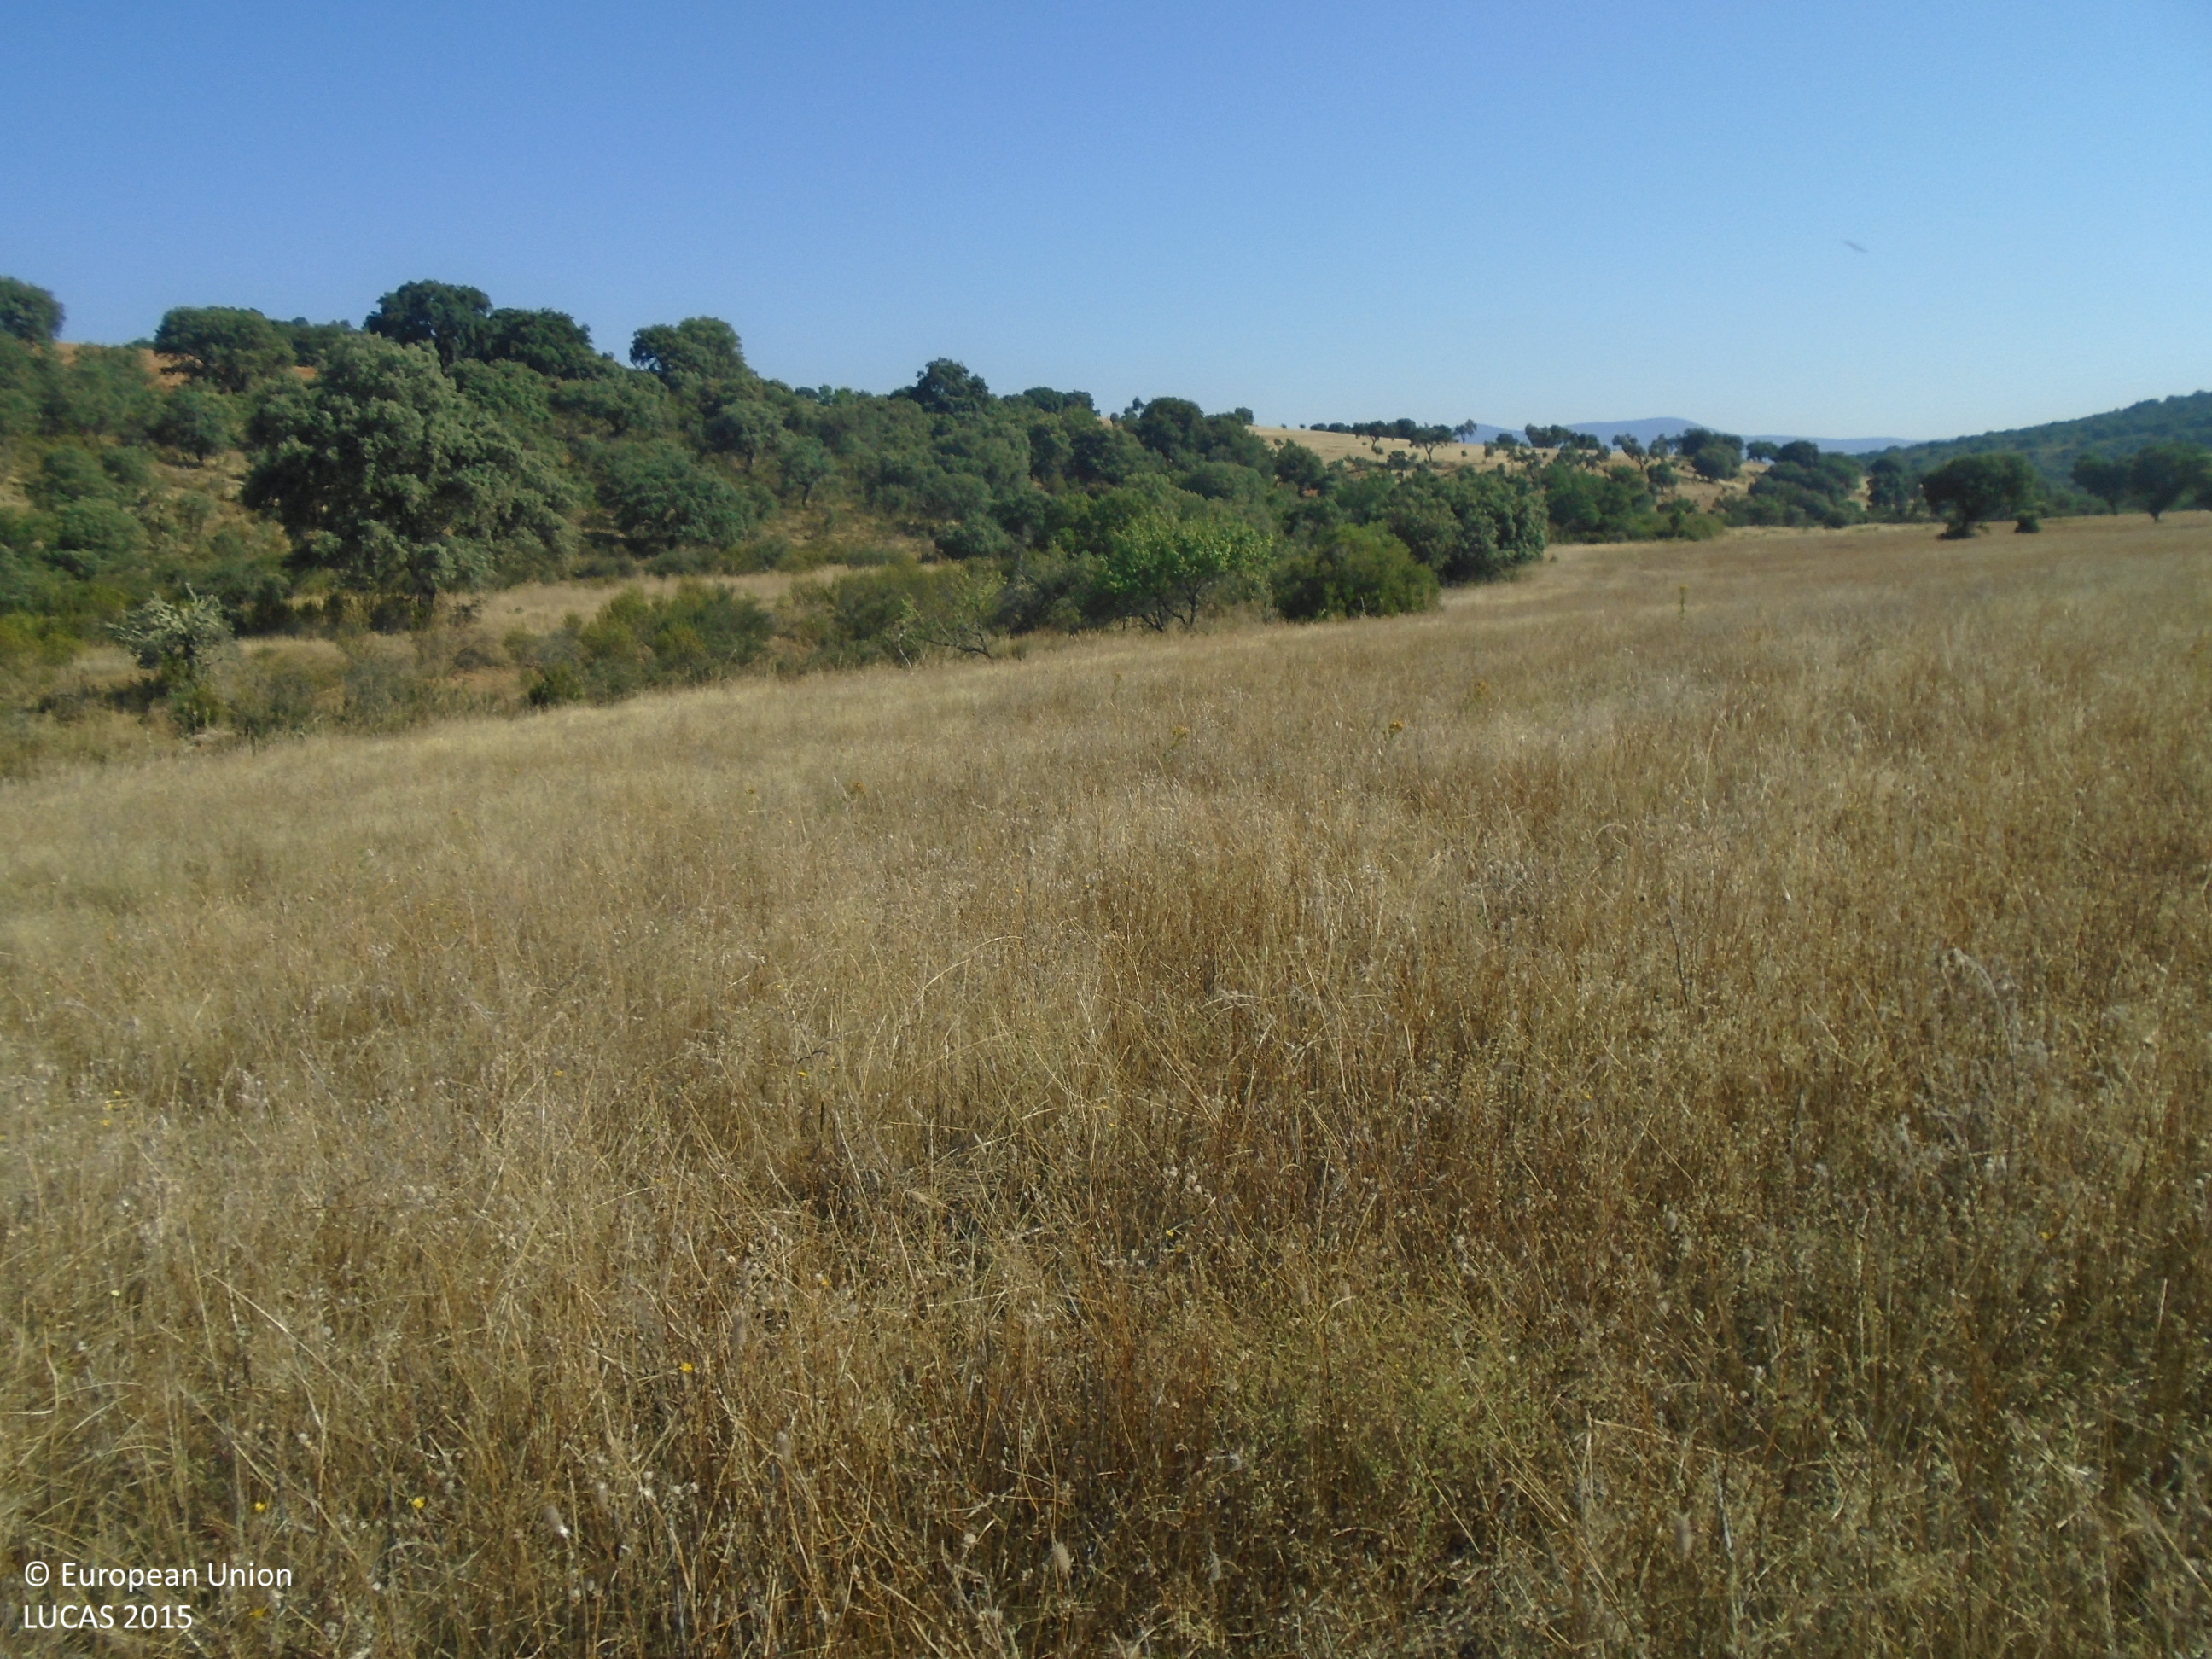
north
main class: Grassland
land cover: Grassland without tree/shrub cover
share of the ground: > 75 %
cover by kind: herbaceous plants 100 %
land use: Agriculture (excluding fallow land and kitchen gardens)
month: July
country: ES
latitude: 39.4204
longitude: -4.8736
